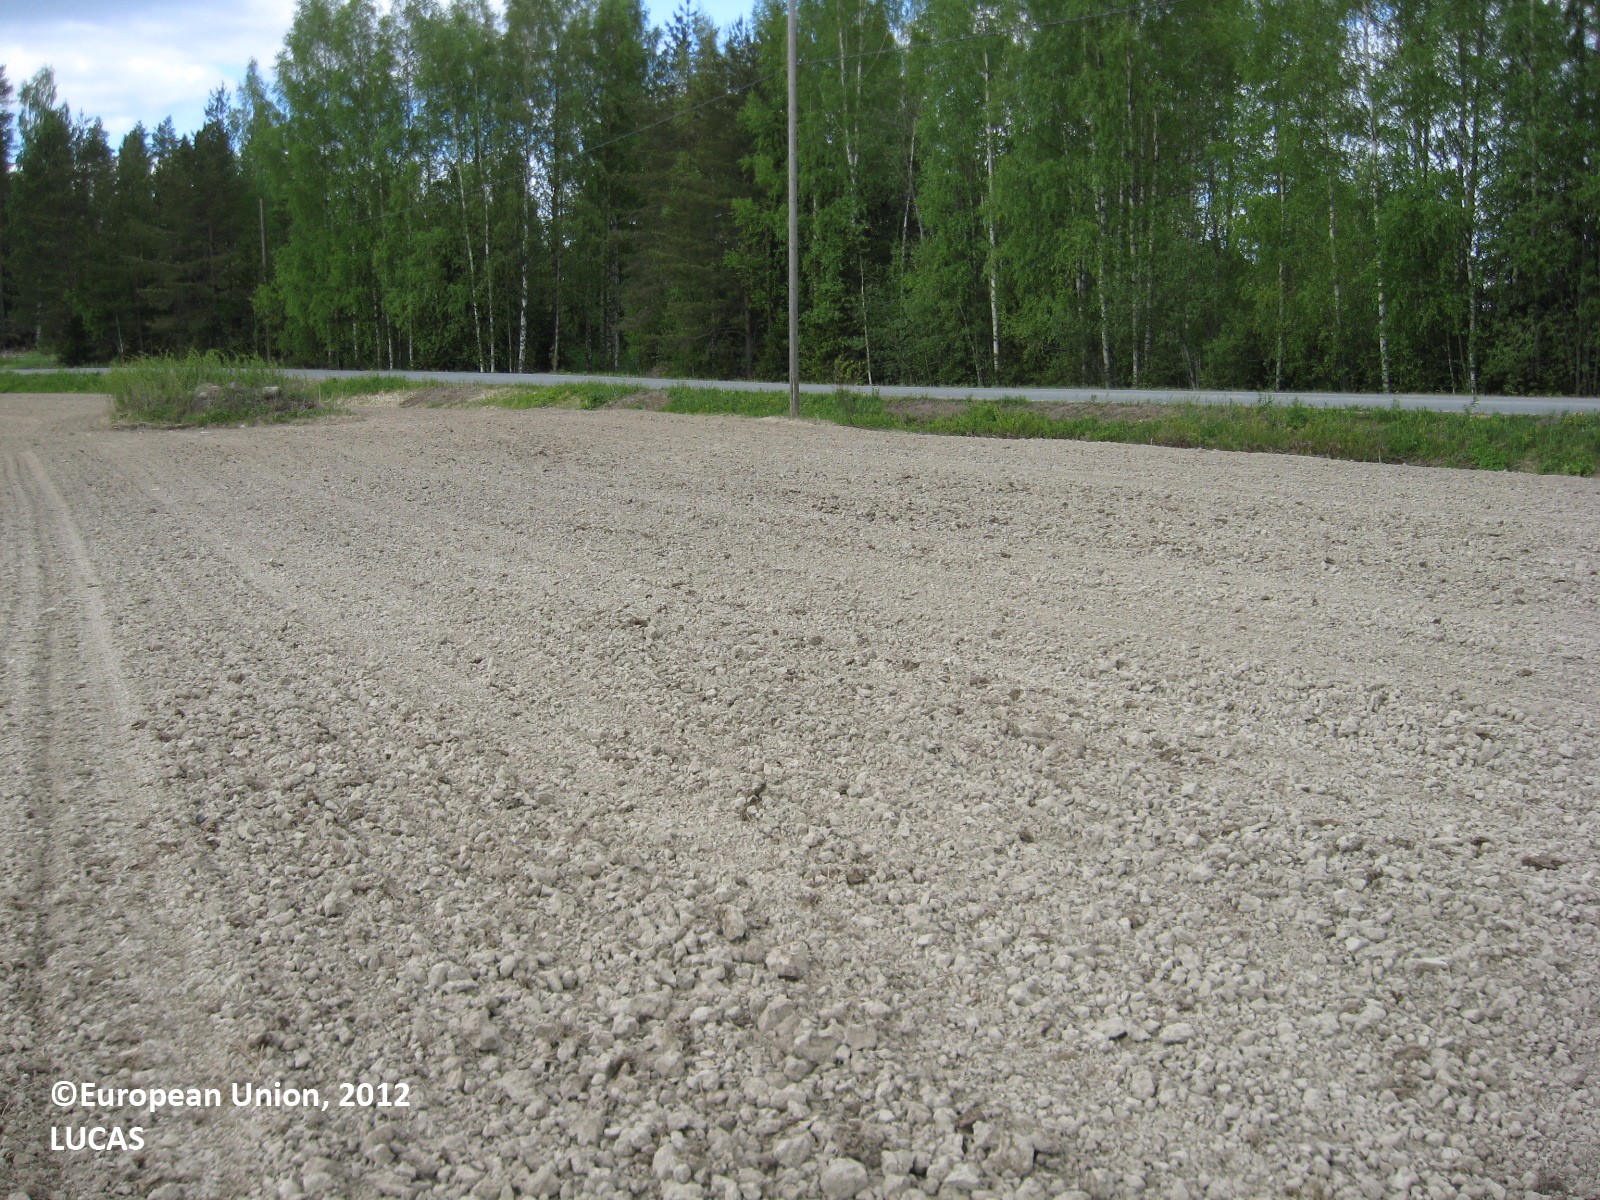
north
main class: Cropland
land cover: Oats
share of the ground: < 10 %
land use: Agriculture (excluding fallow land and kitchen gardens)
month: May
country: FI
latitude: 61.8267
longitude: 22.5739
